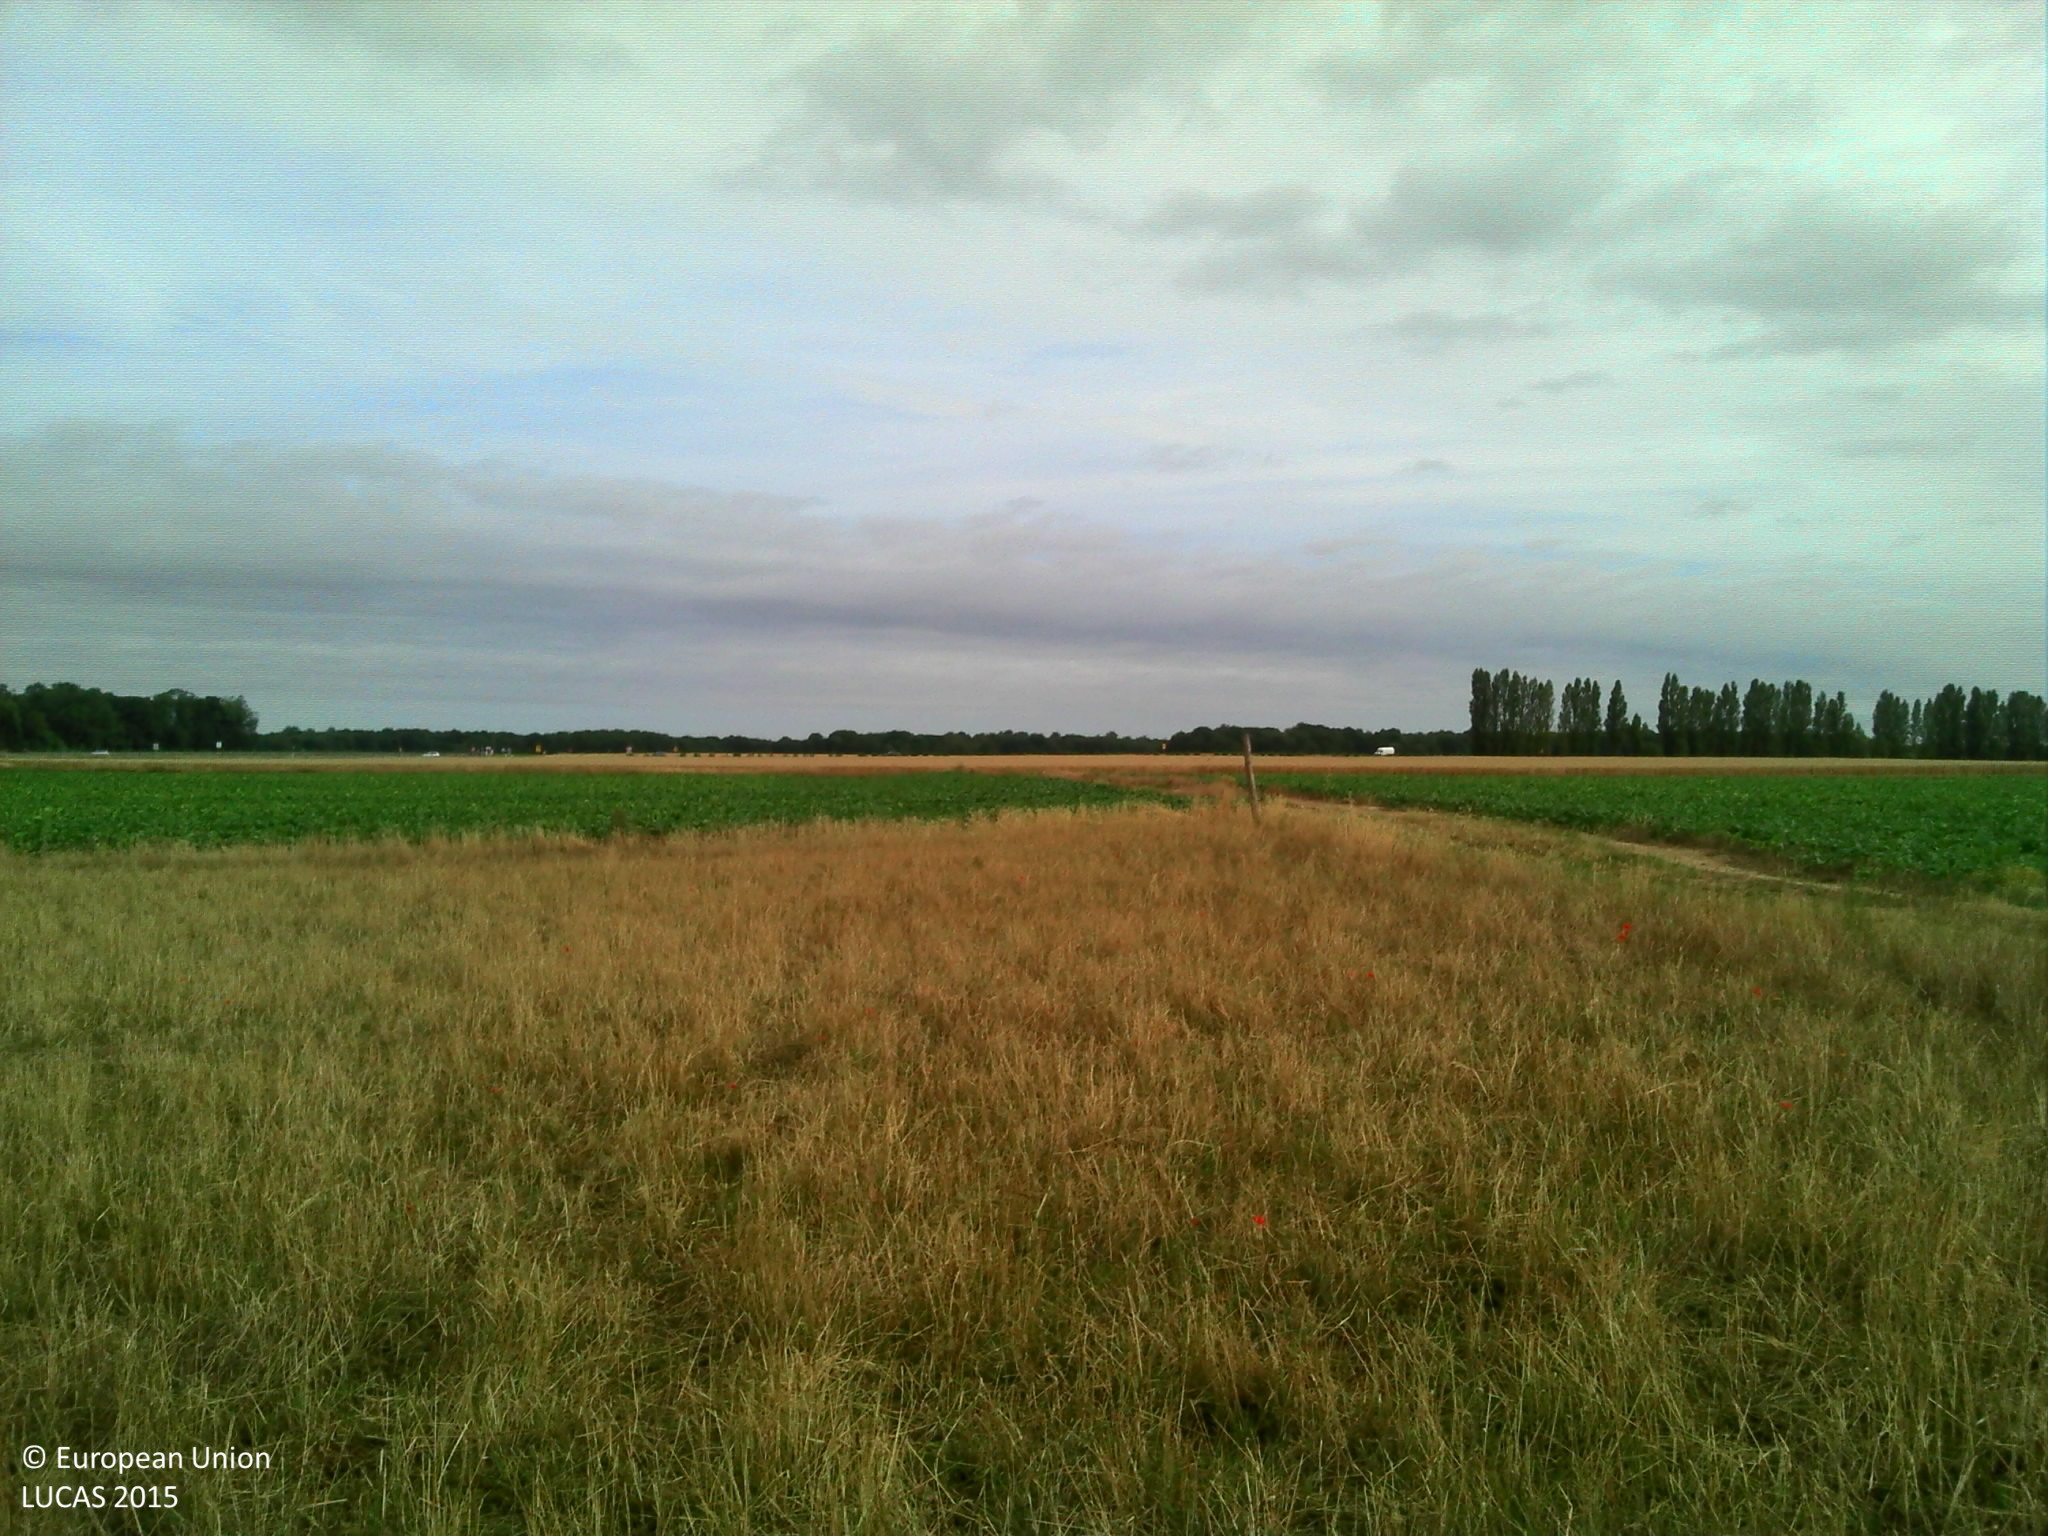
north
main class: Grassland
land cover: Grassland without tree/shrub cover
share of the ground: > 75 %
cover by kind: herbaceous plants 100 %
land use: Agriculture (excluding fallow land and kitchen gardens)
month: July
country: FR
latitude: 49.1666
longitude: 2.8723
